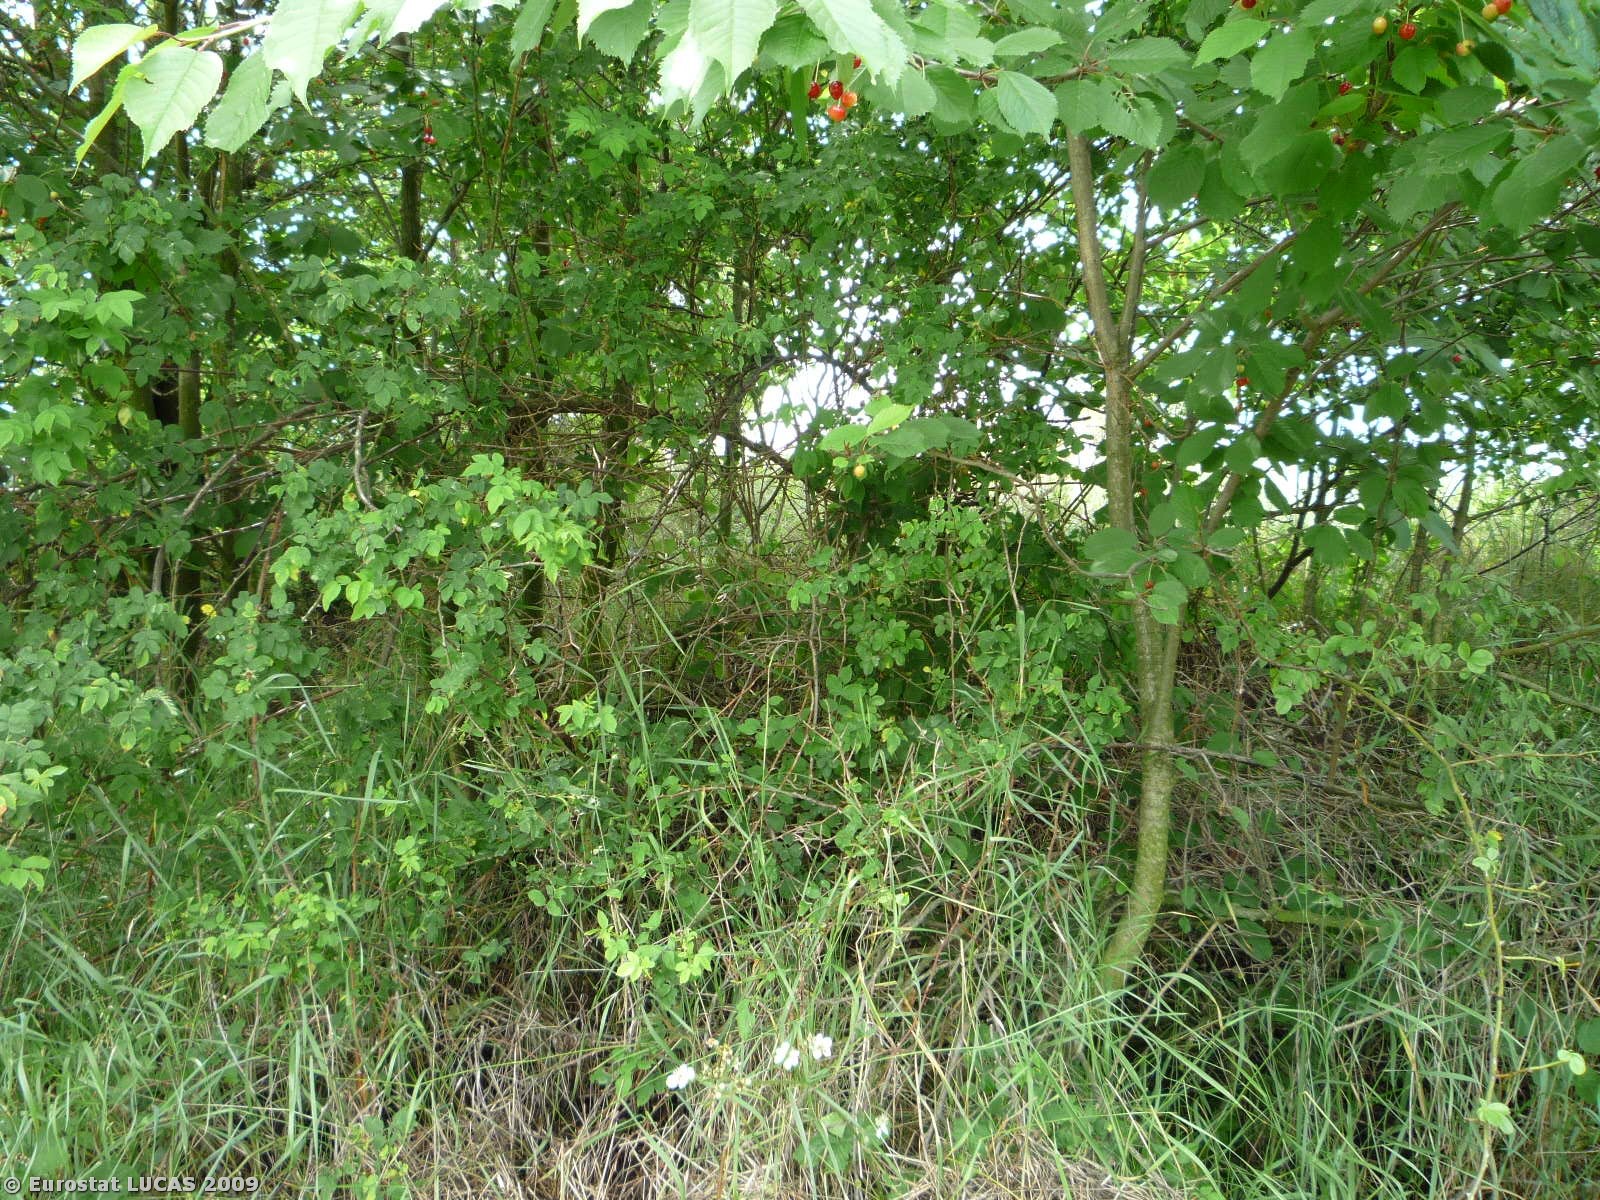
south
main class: Grassland
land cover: Grassland without tree/shrub cover
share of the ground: > 75 %
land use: Agriculture (excluding fallow land and kitchen gardens)
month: June
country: CZ
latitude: 50.0033
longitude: 14.9835
